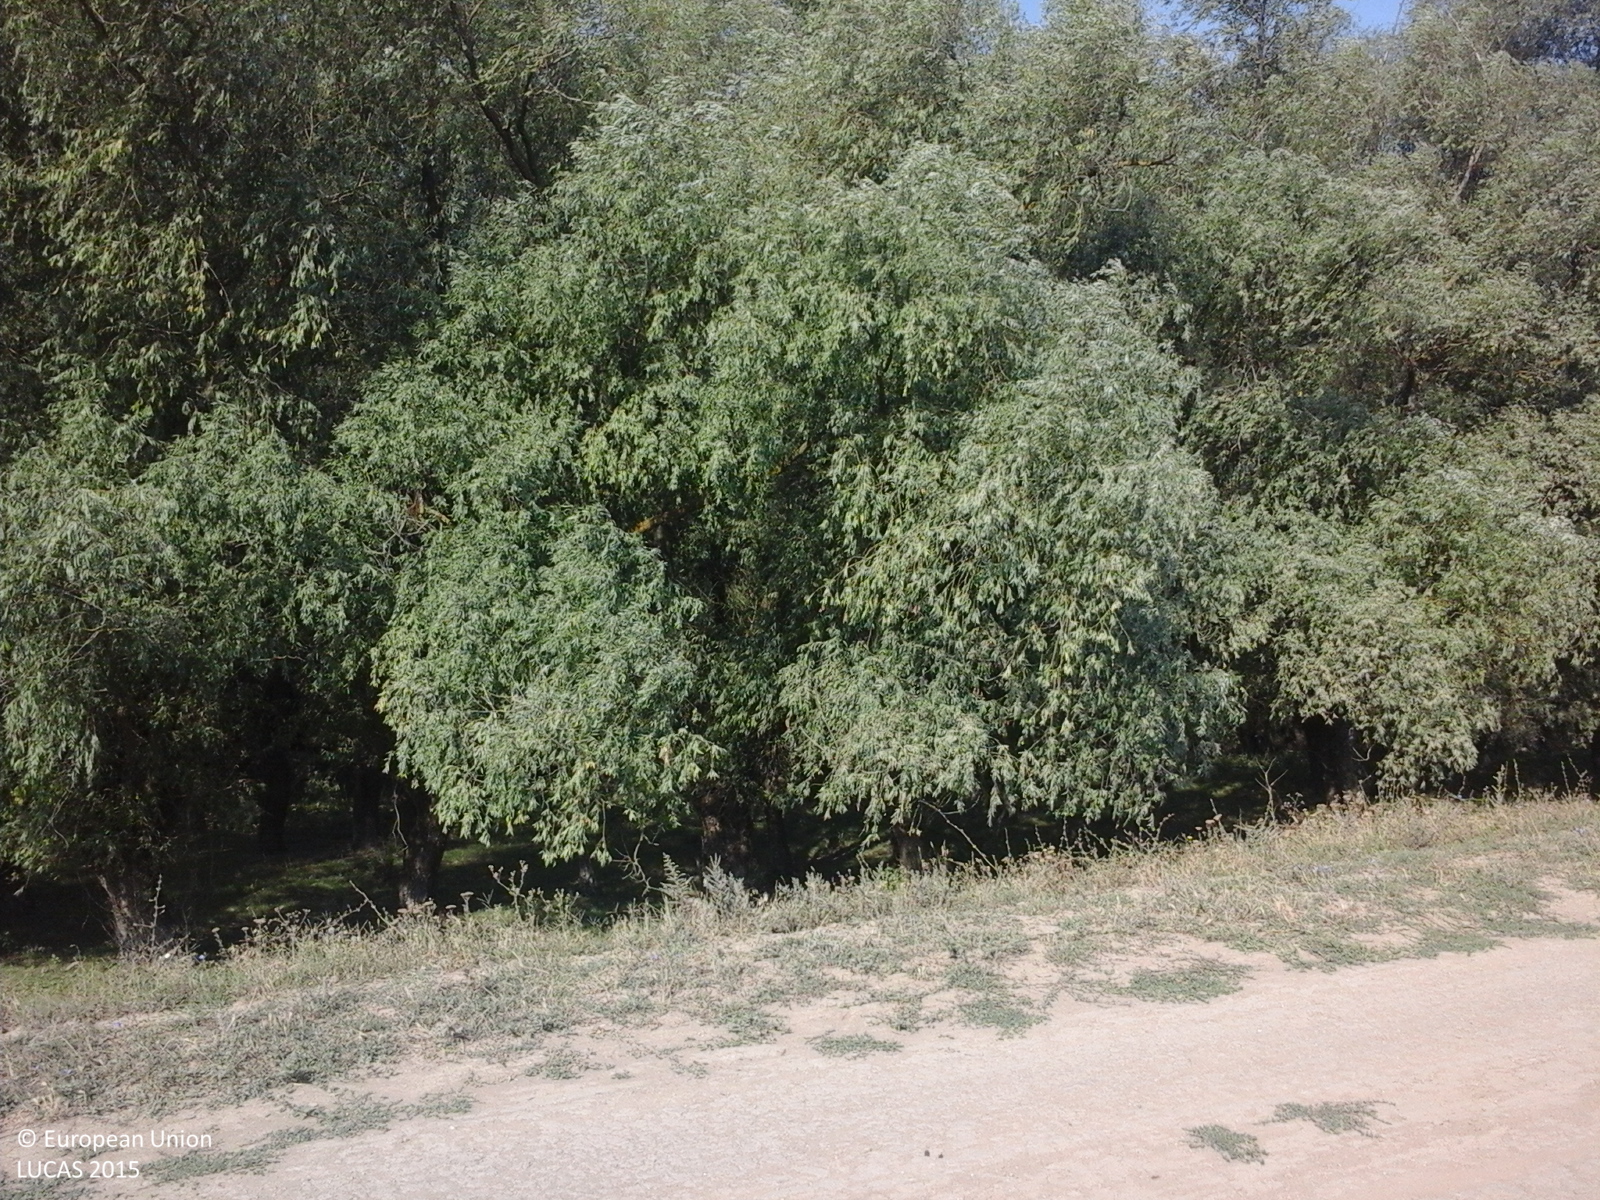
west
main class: Grassland
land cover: Spontaneously vegetated surfaces
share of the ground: > 75 %
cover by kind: herbaceous plants 100 %
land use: Agriculture (excluding fallow land and kitchen gardens)
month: August
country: RO
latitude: 45.2169
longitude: 27.9801
